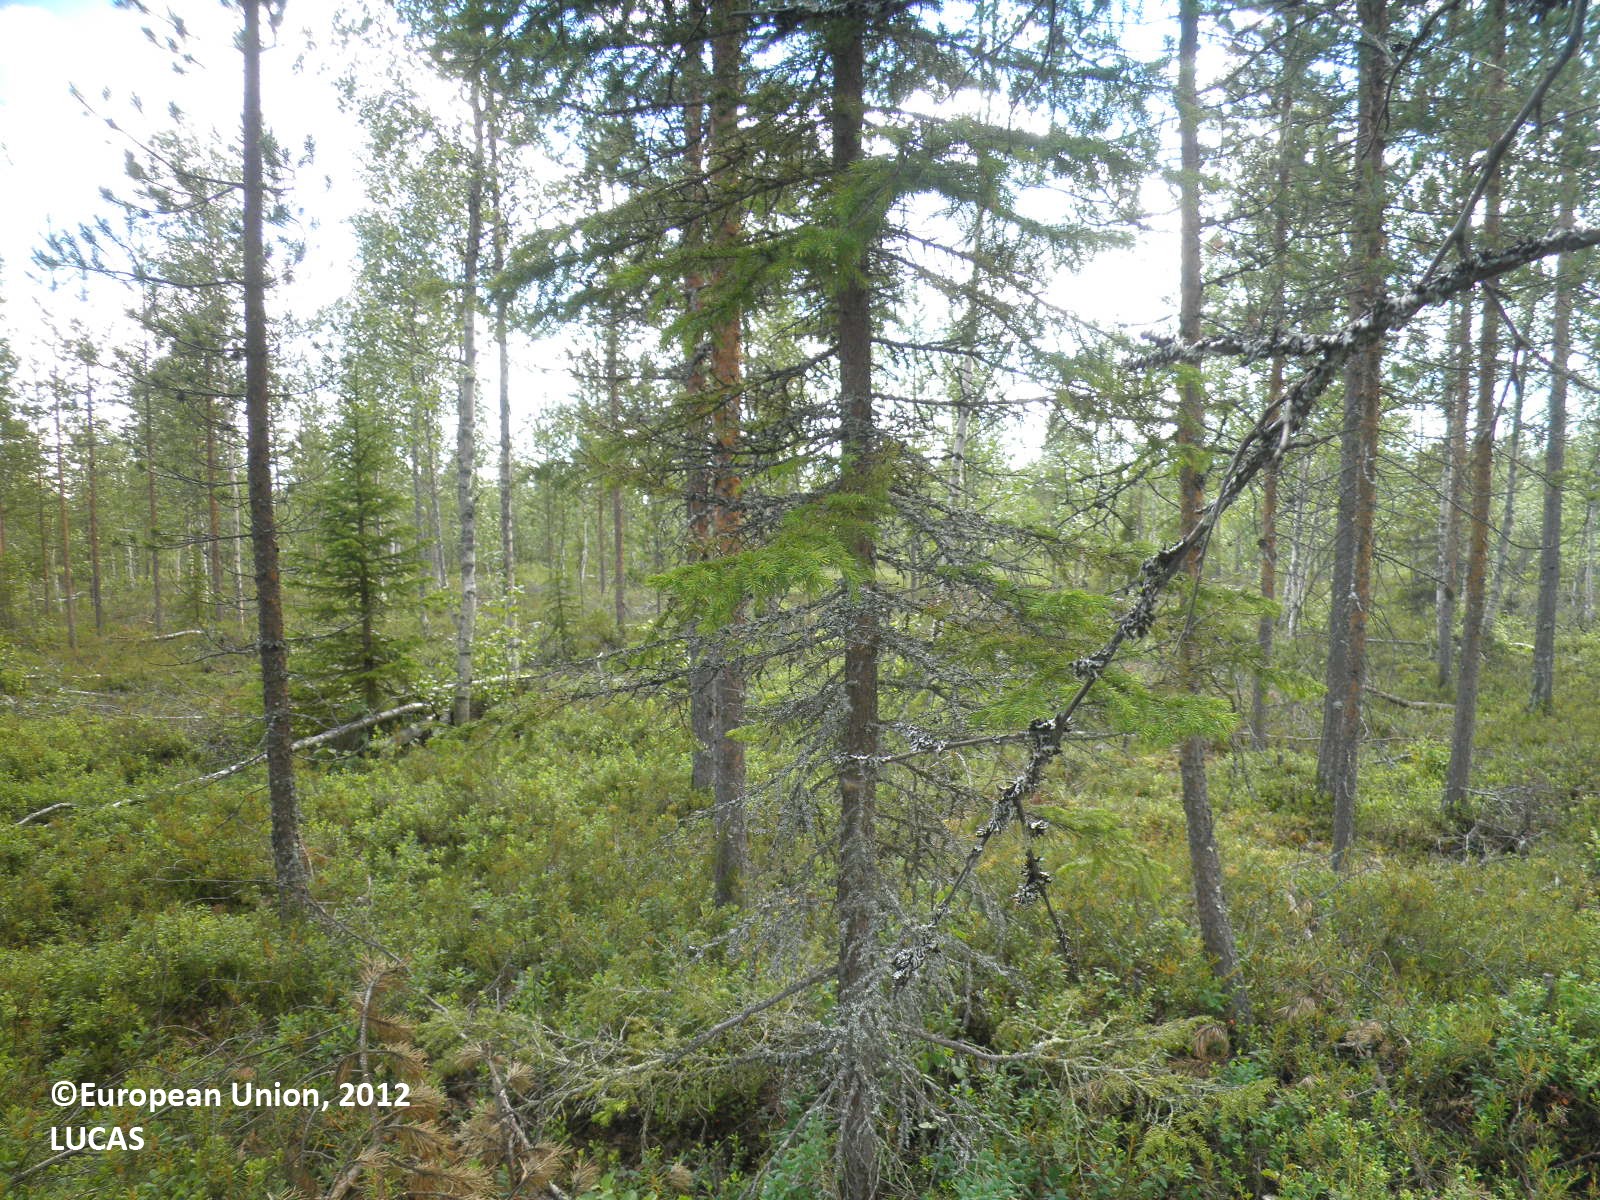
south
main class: Woodland
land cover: Pine dominated mixed woodland
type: boreal forest
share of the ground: 25 - 50 %
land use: Forestry
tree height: > 5 m
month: July
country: FI
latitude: 67.4515
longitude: 26.8359
